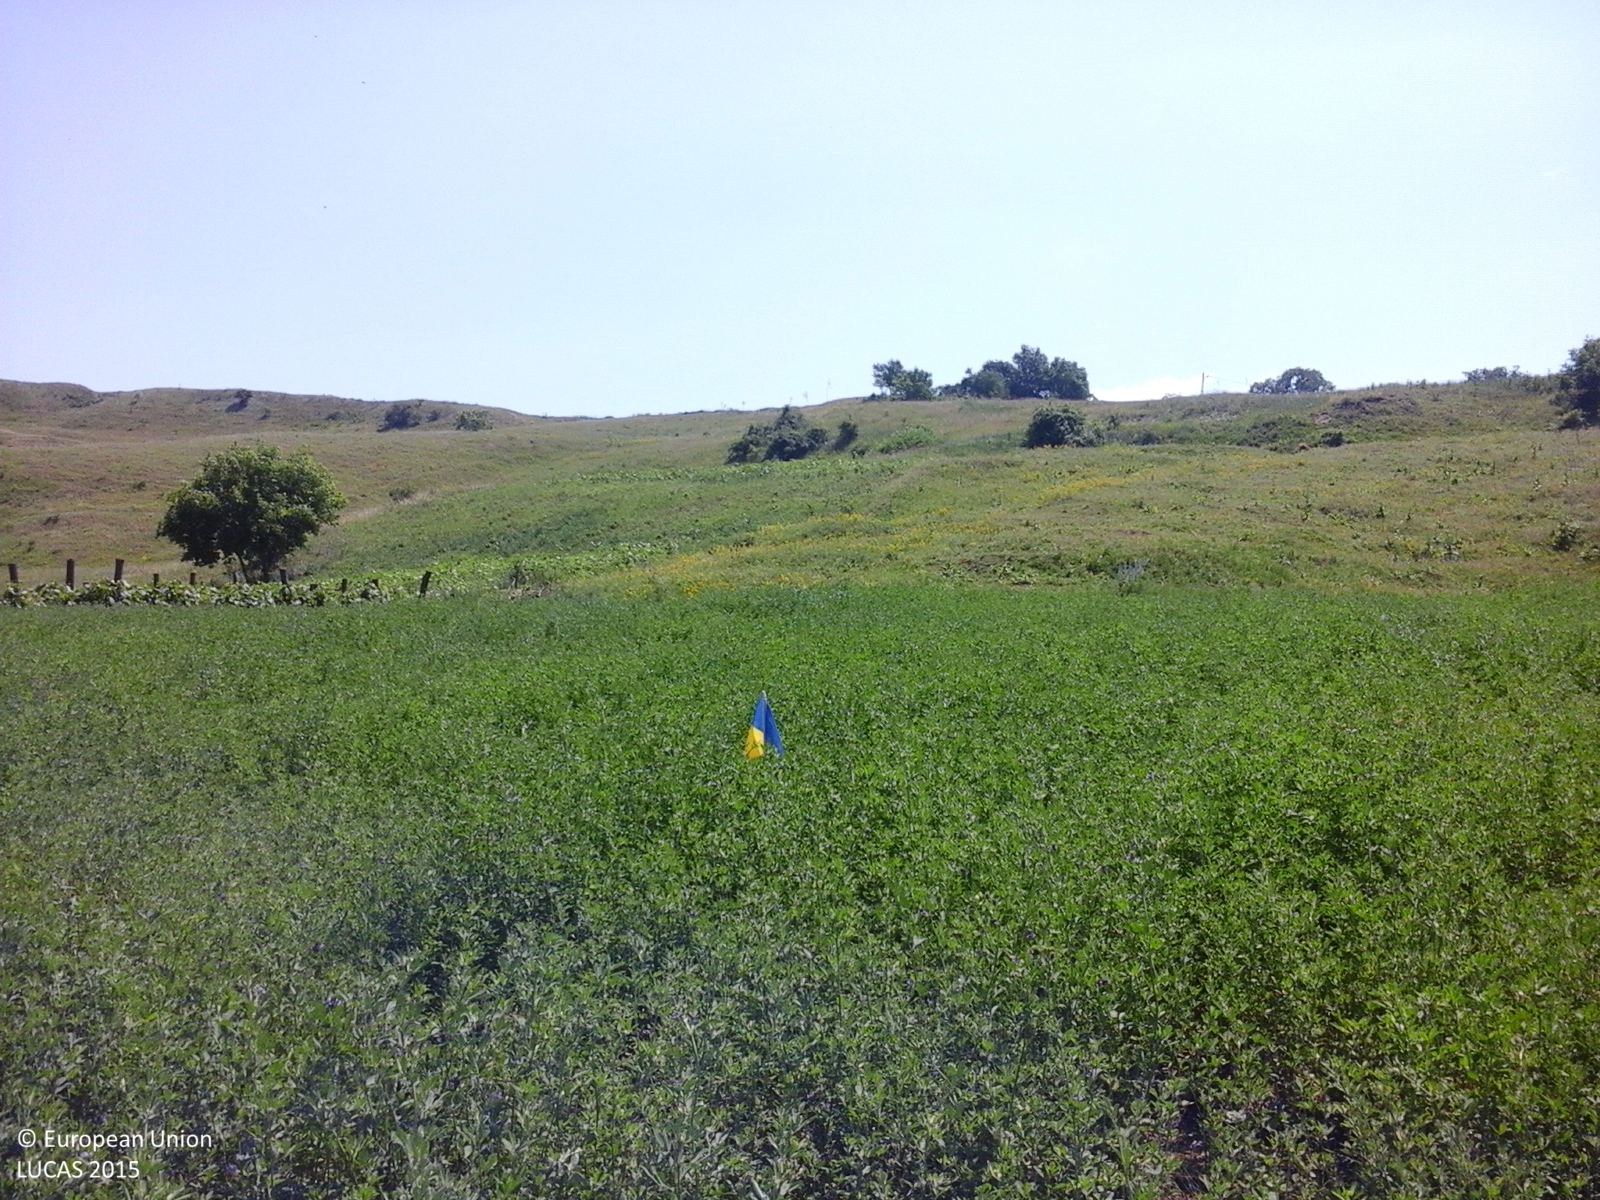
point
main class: Cropland
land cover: Lucerne
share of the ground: > 75 %
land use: Agriculture (excluding fallow land and kitchen gardens)
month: June
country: RO
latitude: 46.7946
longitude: 27.3630
